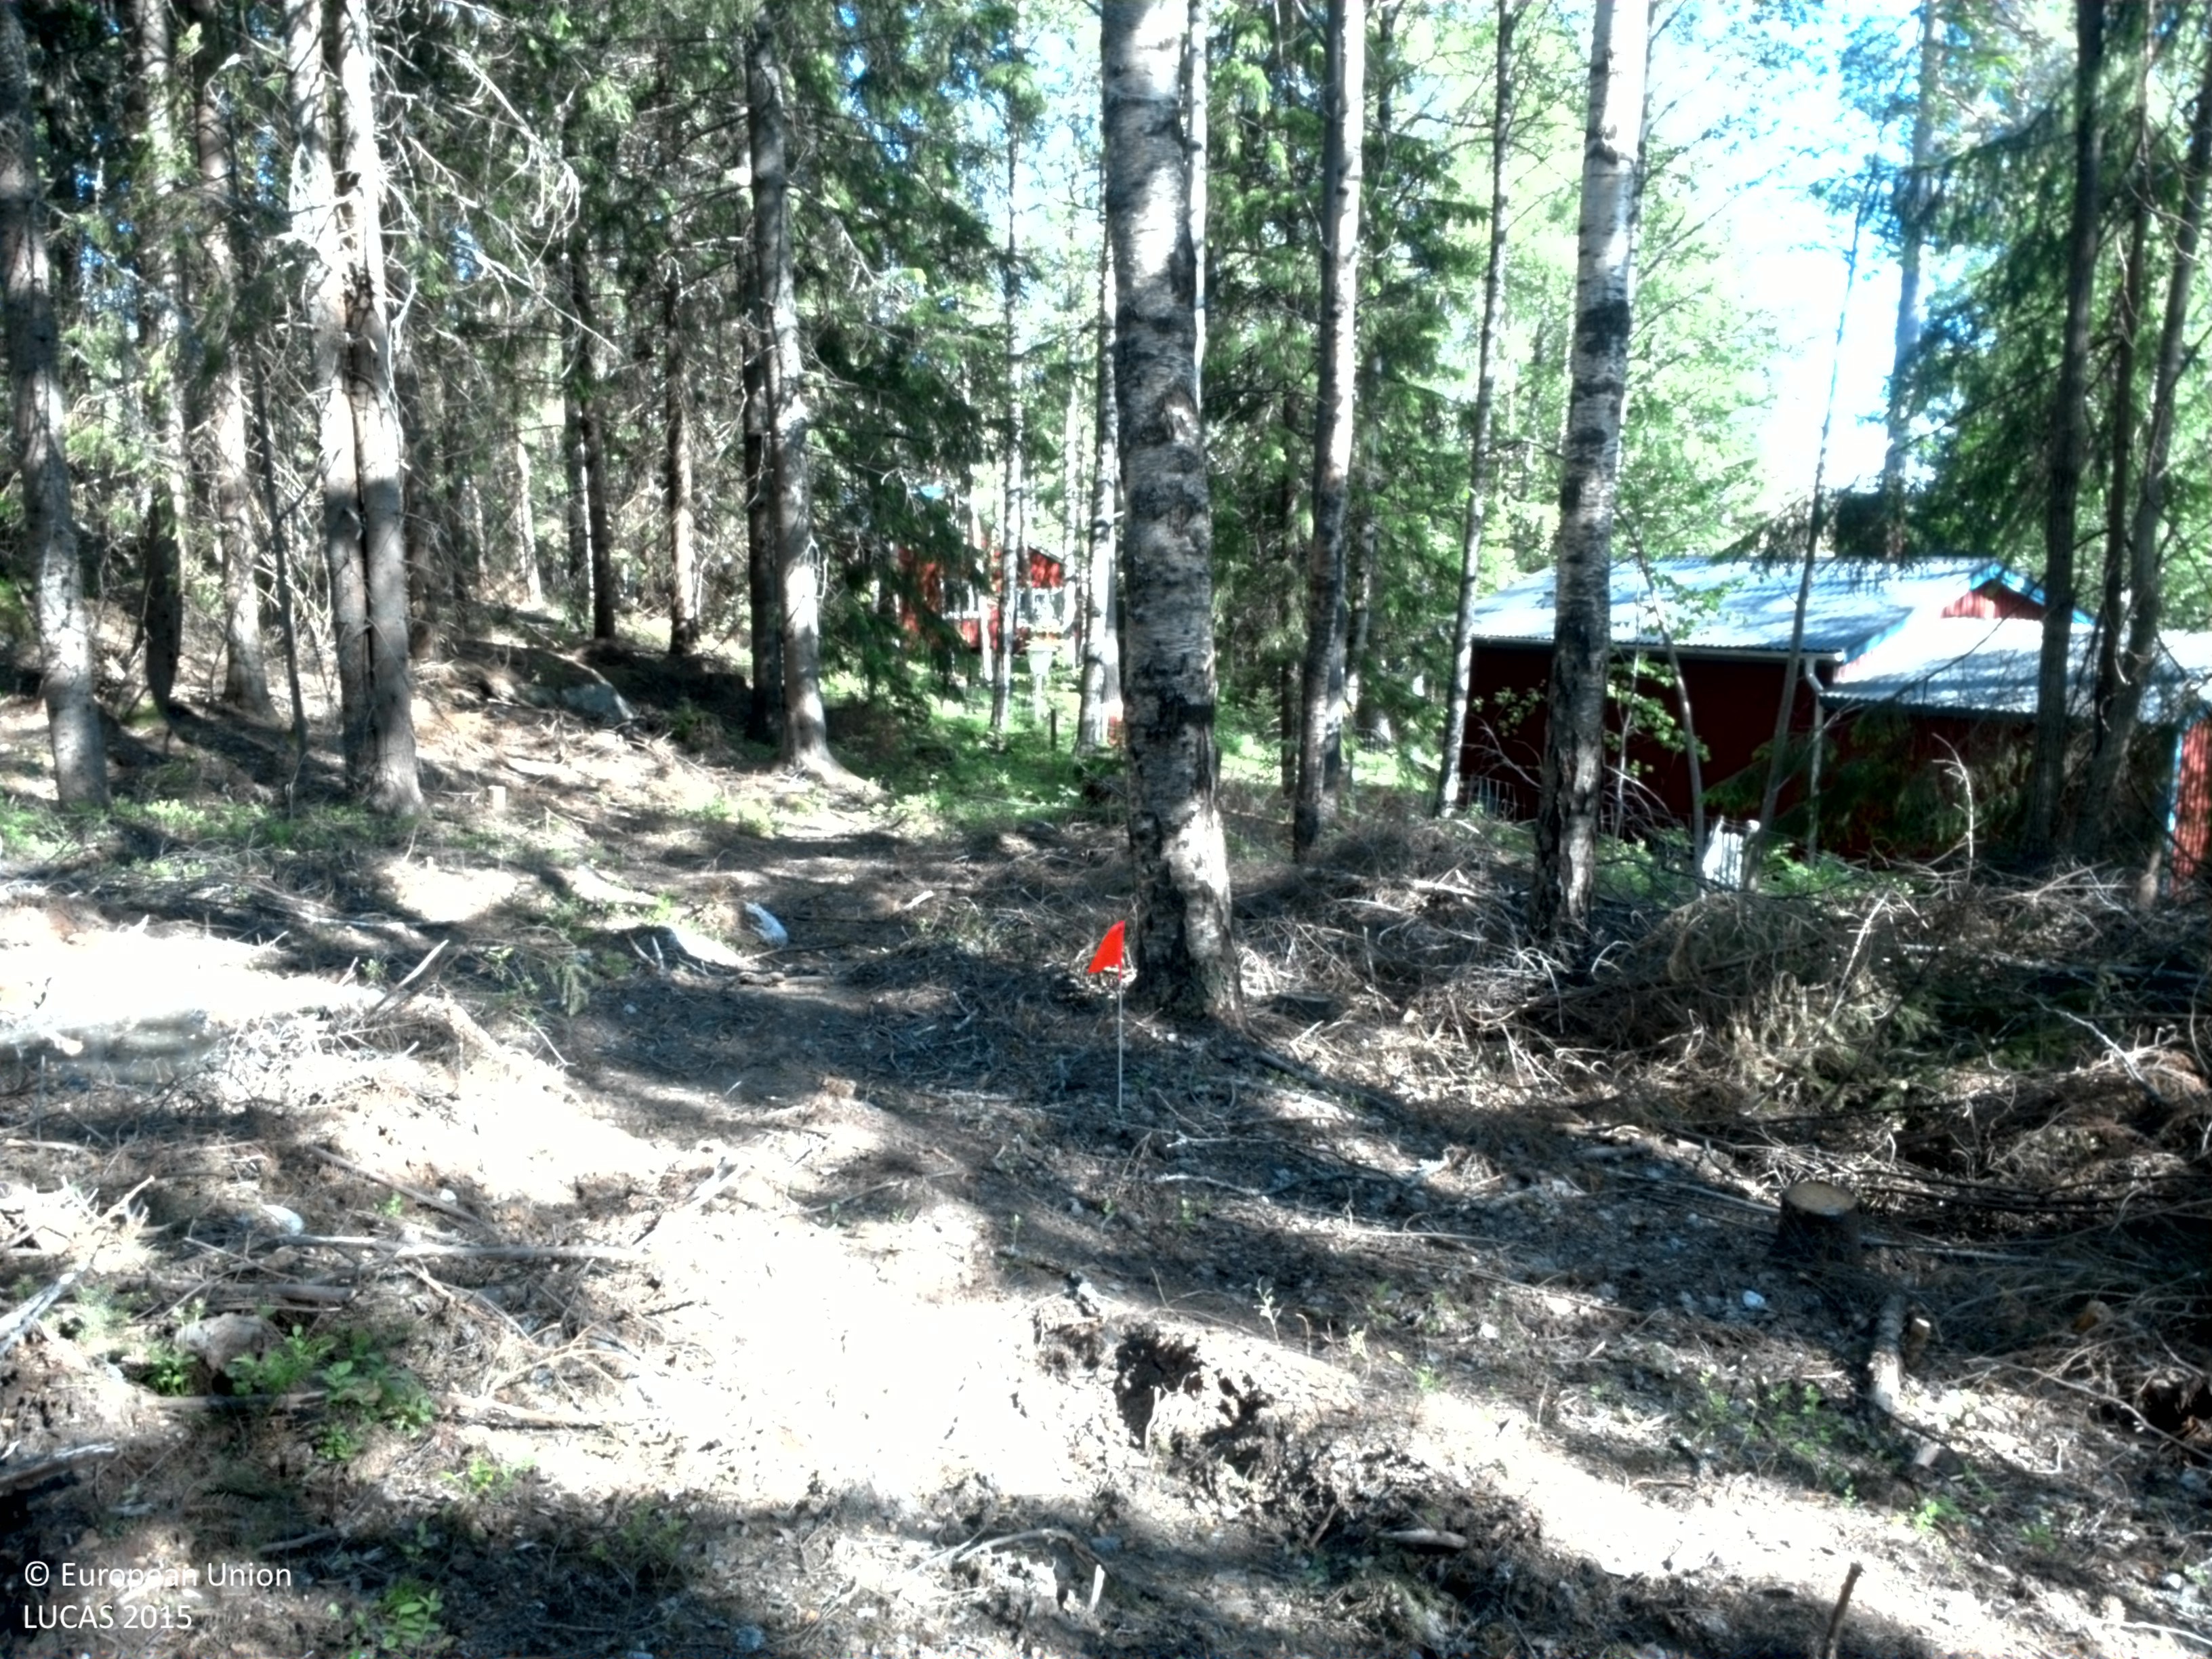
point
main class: Woodland
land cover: Spruce dominated mixed woodland
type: boreal forest
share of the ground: 50 - 75 %
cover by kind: coniferous forest trees 35 %, broadleaved forest trees 25 %, unconsolidated bare surface 15 %, shrubs 10 %, herbaceous plants 5 %
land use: Forestry
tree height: > 5 m
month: June
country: SE
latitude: 59.2928
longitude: 14.6440
